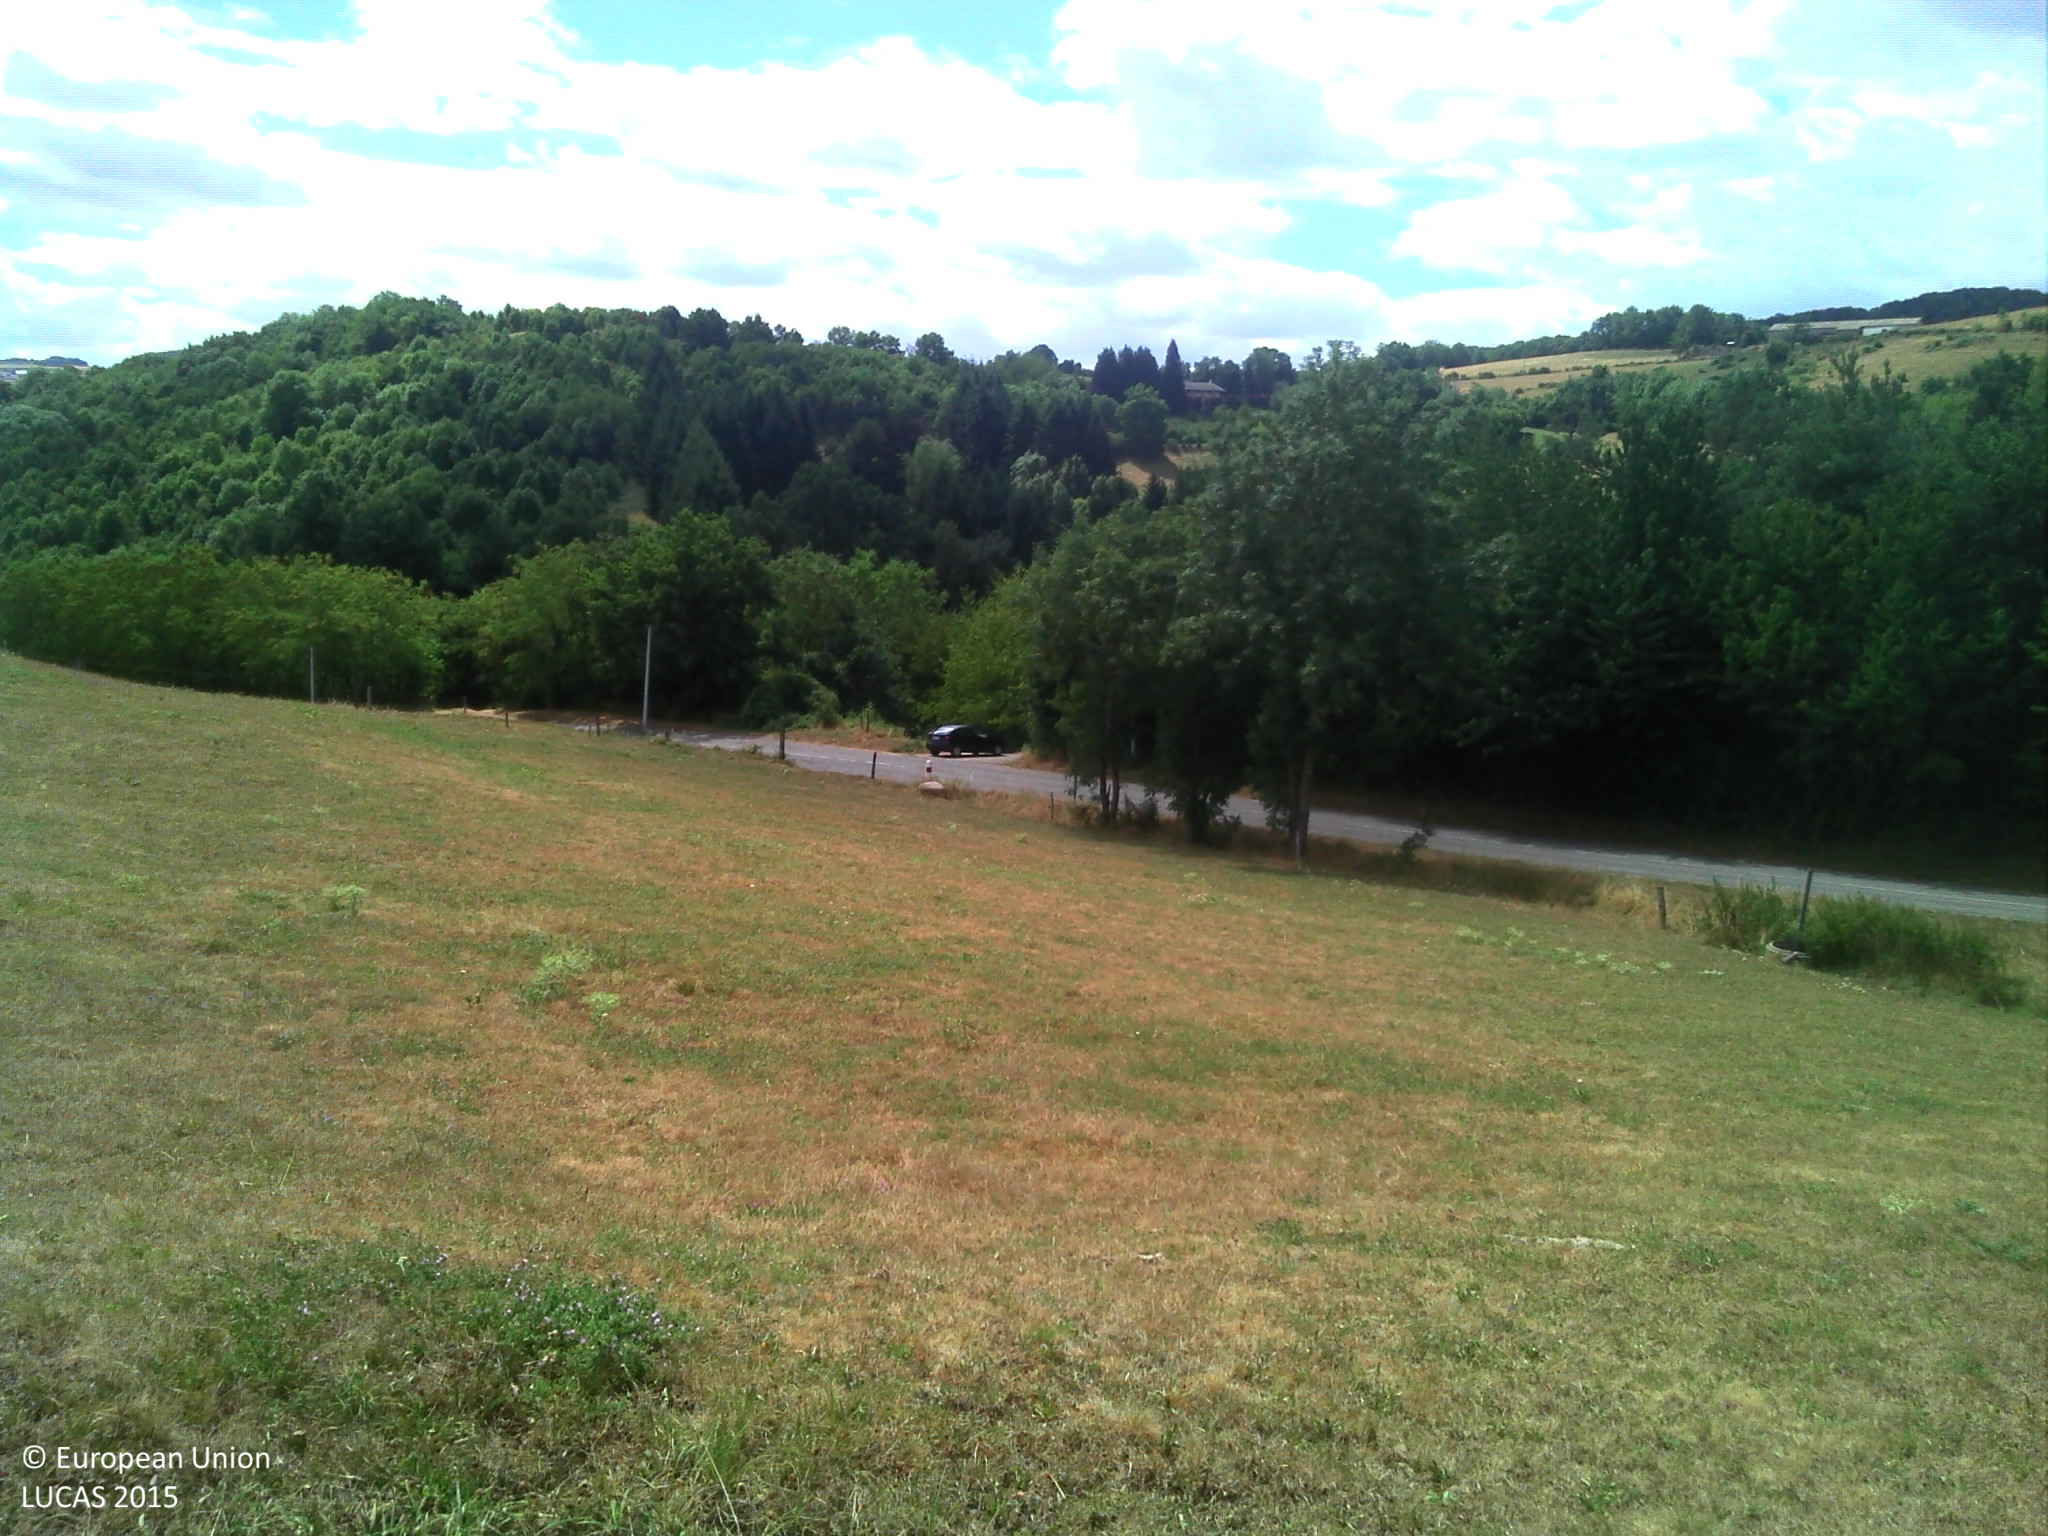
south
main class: Grassland
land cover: Grassland without tree/shrub cover
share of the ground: > 75 %
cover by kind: herbaceous plants 100 %
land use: Agriculture (excluding fallow land and kitchen gardens)
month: July
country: FR
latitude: 45.7398
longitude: 4.4895
